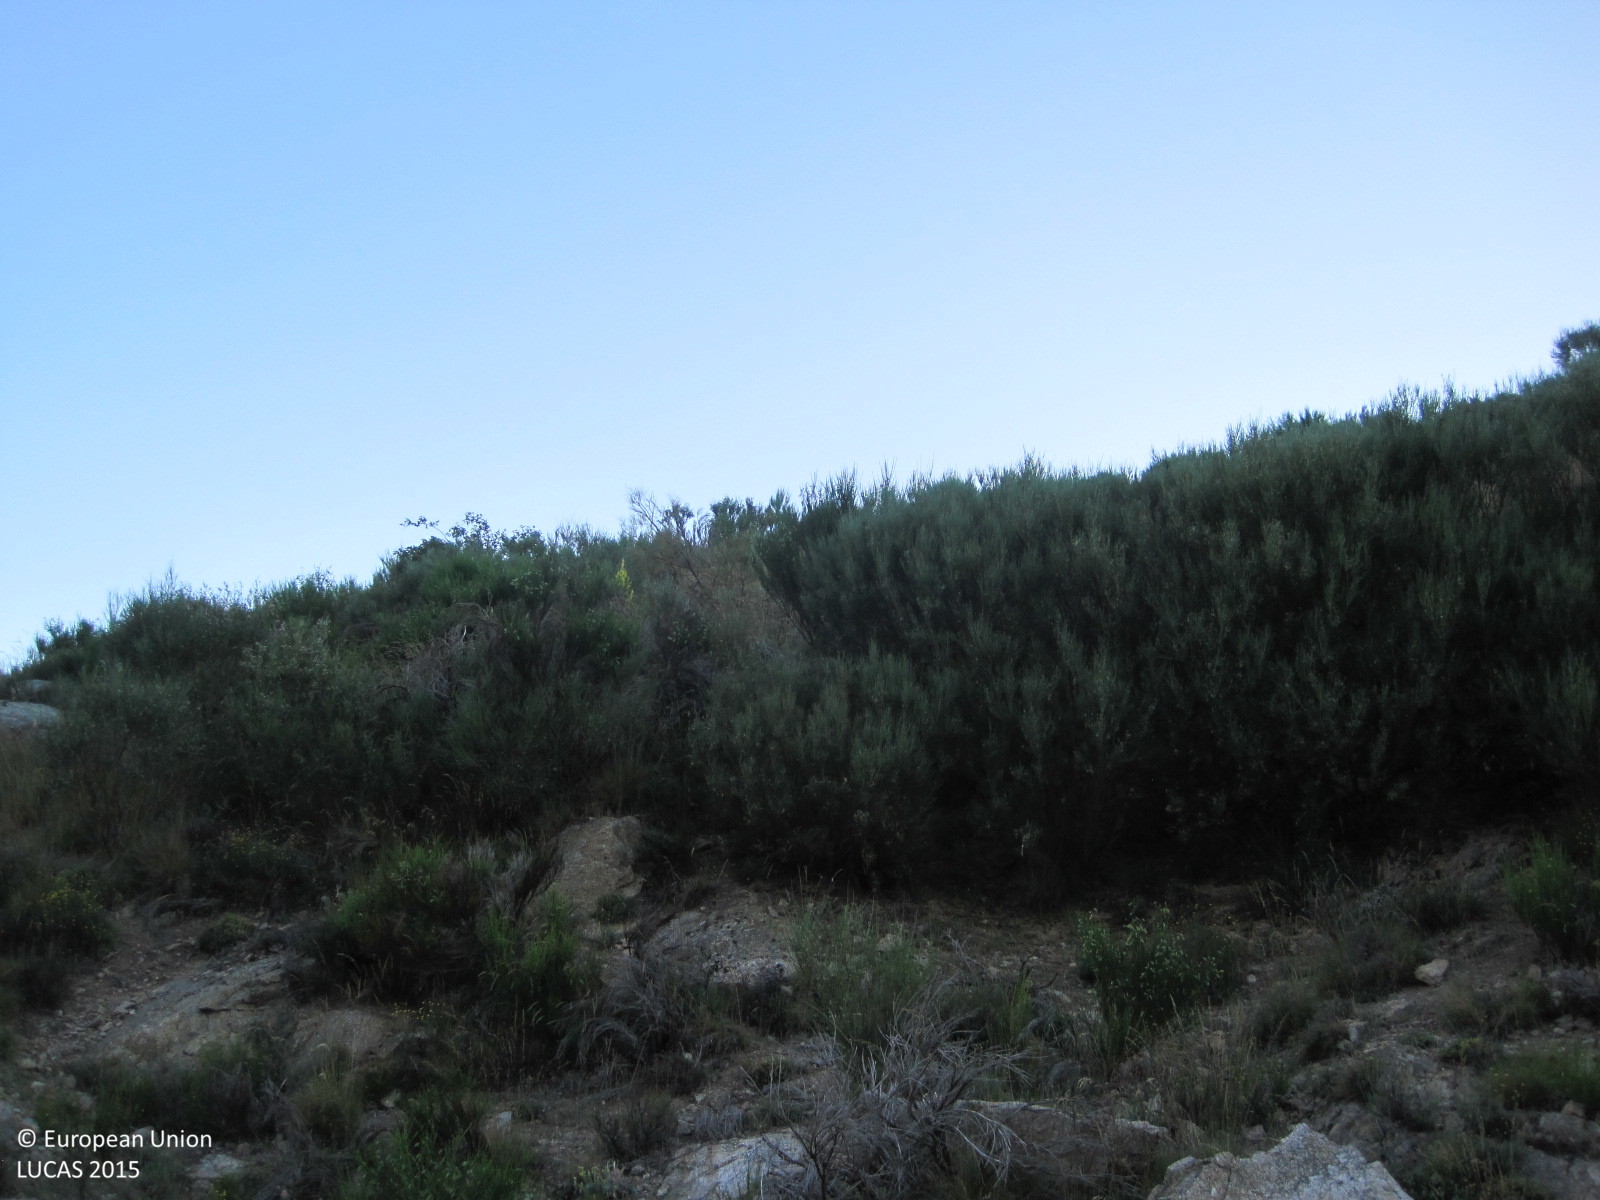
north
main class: Shrubland
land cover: Shrubland without tree cover
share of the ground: > 75 %
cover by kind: shrubs 100 %
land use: Semi-natural and natural areas not in use
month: June
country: ES
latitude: 40.3375
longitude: -5.2335
